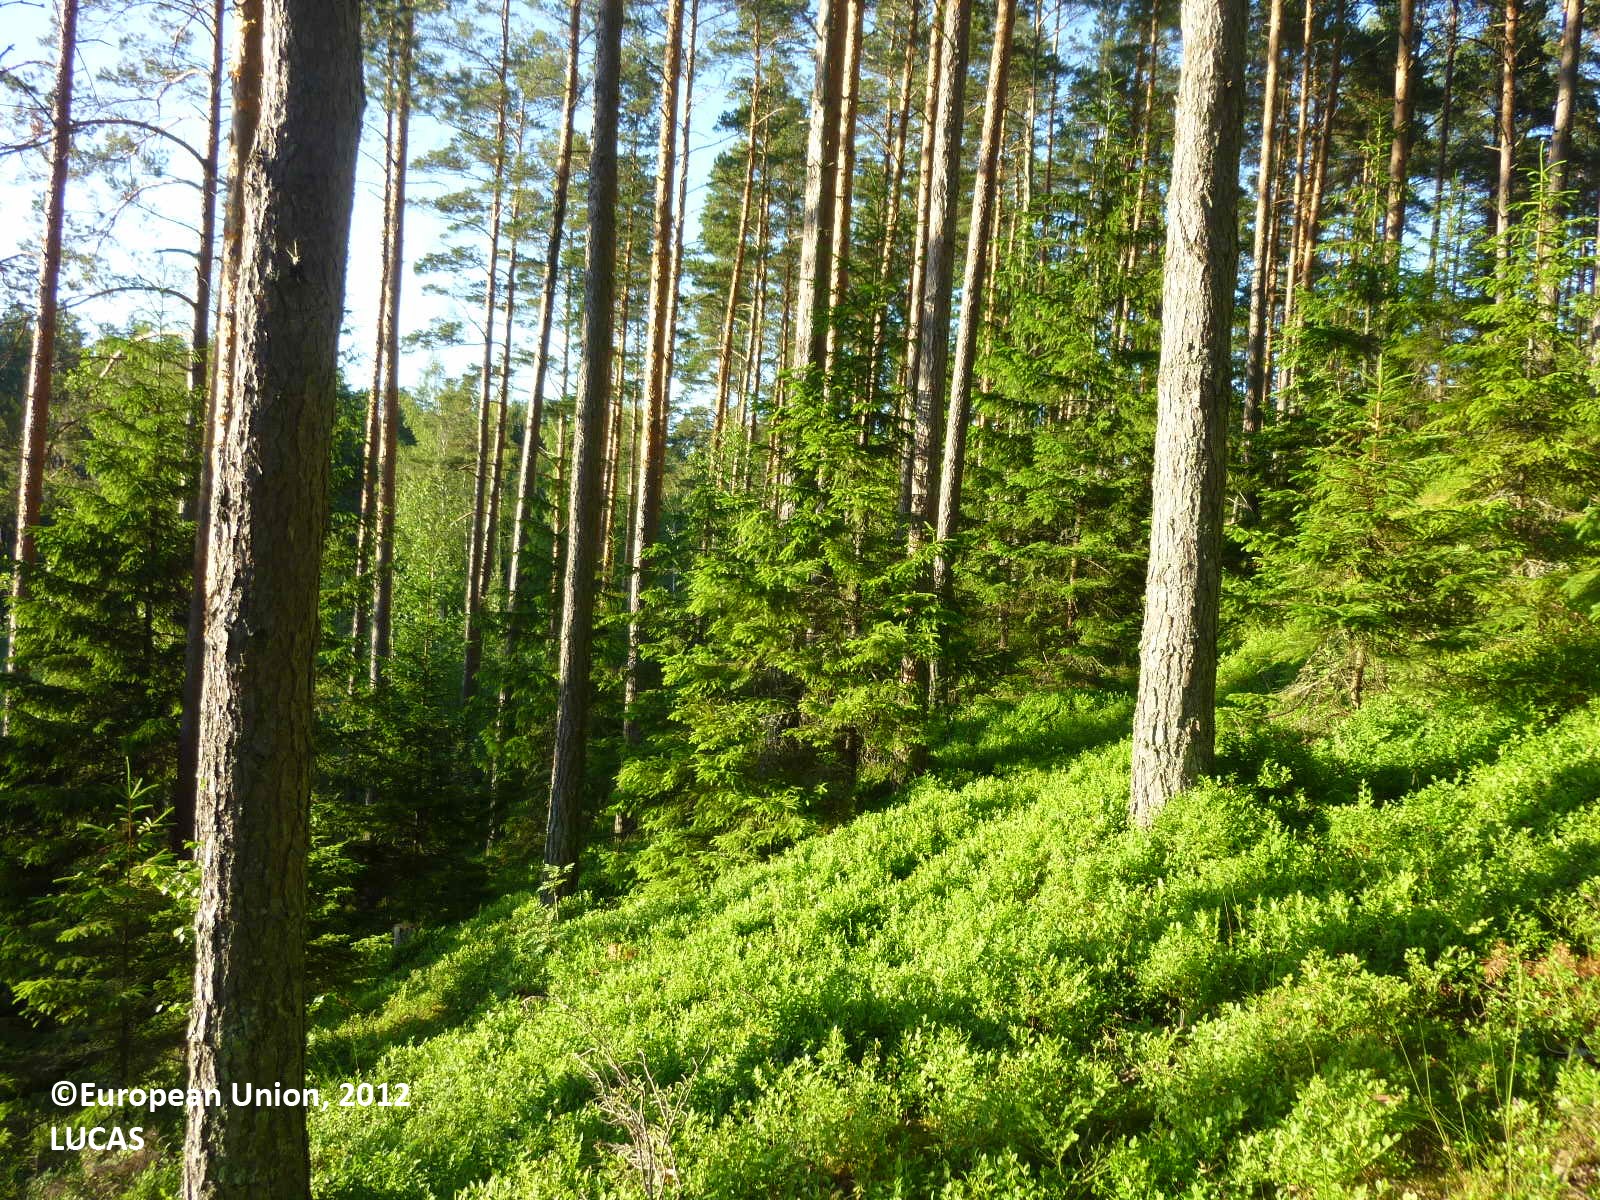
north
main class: Woodland
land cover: Pine dominated coniferous woodland
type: boreal forest
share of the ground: 50 - 75 %
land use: Forestry
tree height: > 5 m
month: June
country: FI
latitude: 60.0500
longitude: 22.4083
